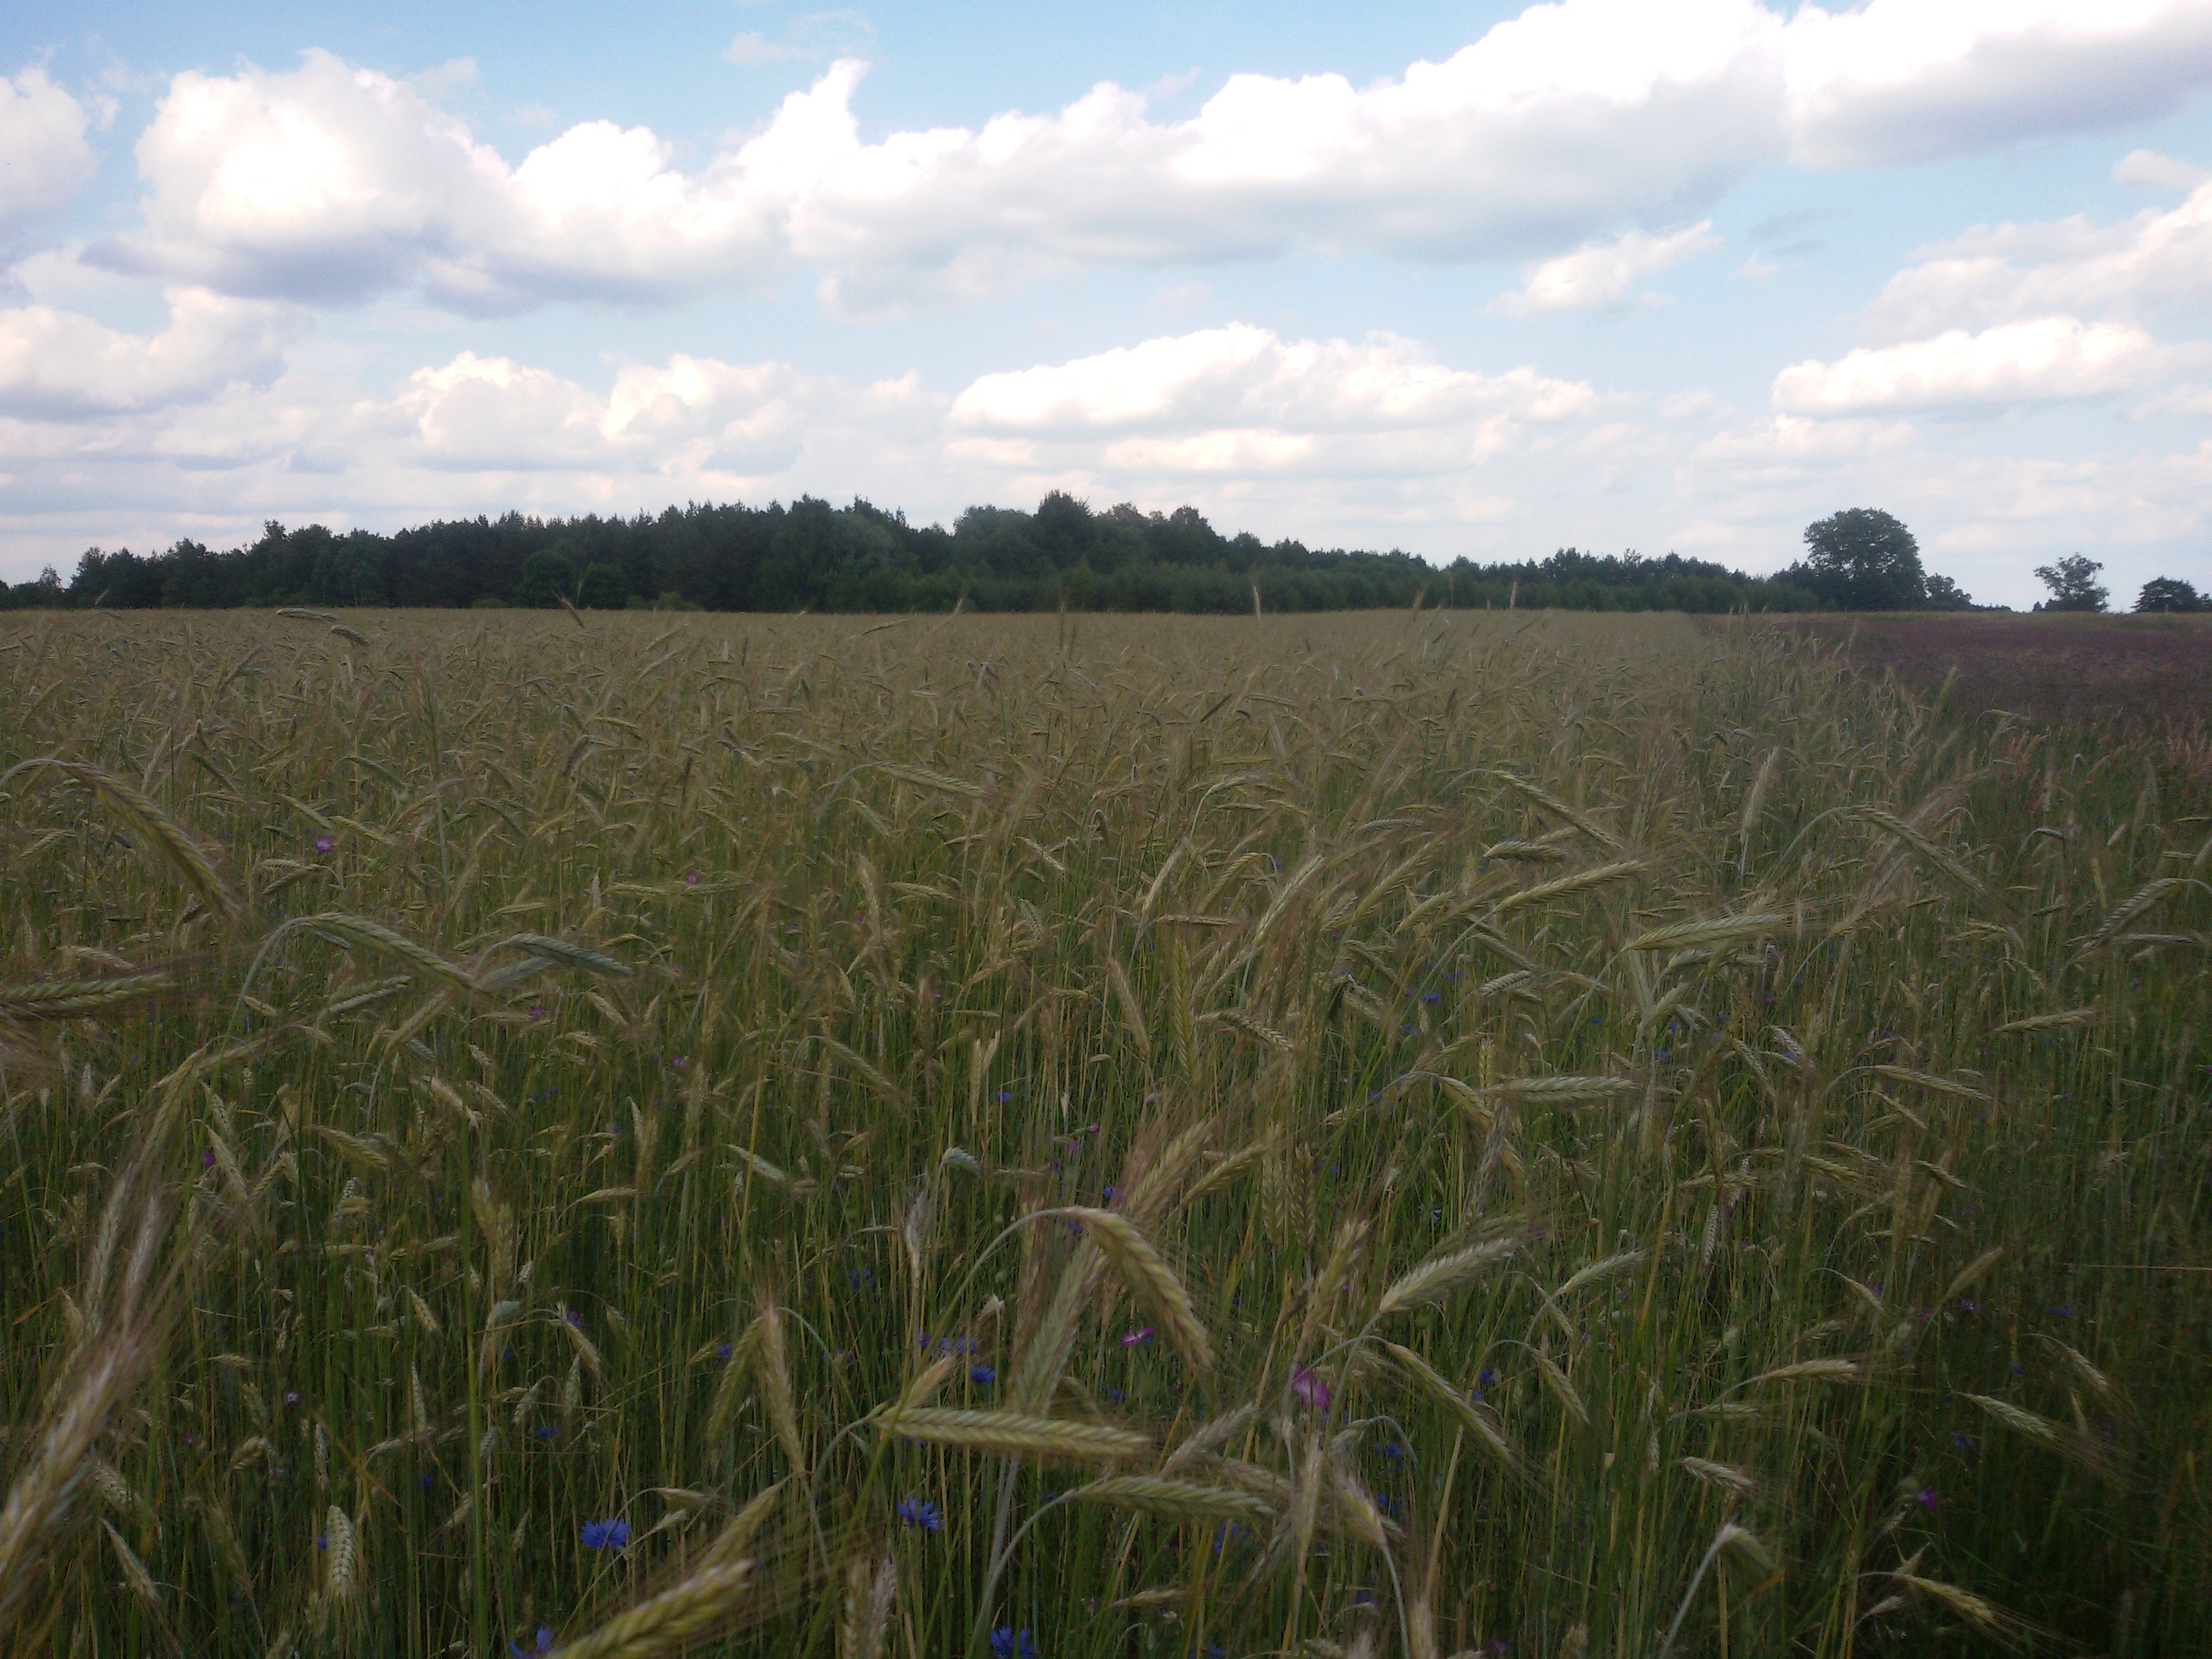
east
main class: Cropland
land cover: Rye
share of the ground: > 75 %
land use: Agriculture (excluding fallow land and kitchen gardens)
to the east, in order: Rye; Lines of trees; Ditches and canals; Paved roads, cycling and walking lanes; Ditches and canals; Lines of trees; Triticale
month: June
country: PL
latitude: 51.7924
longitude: 23.5845
